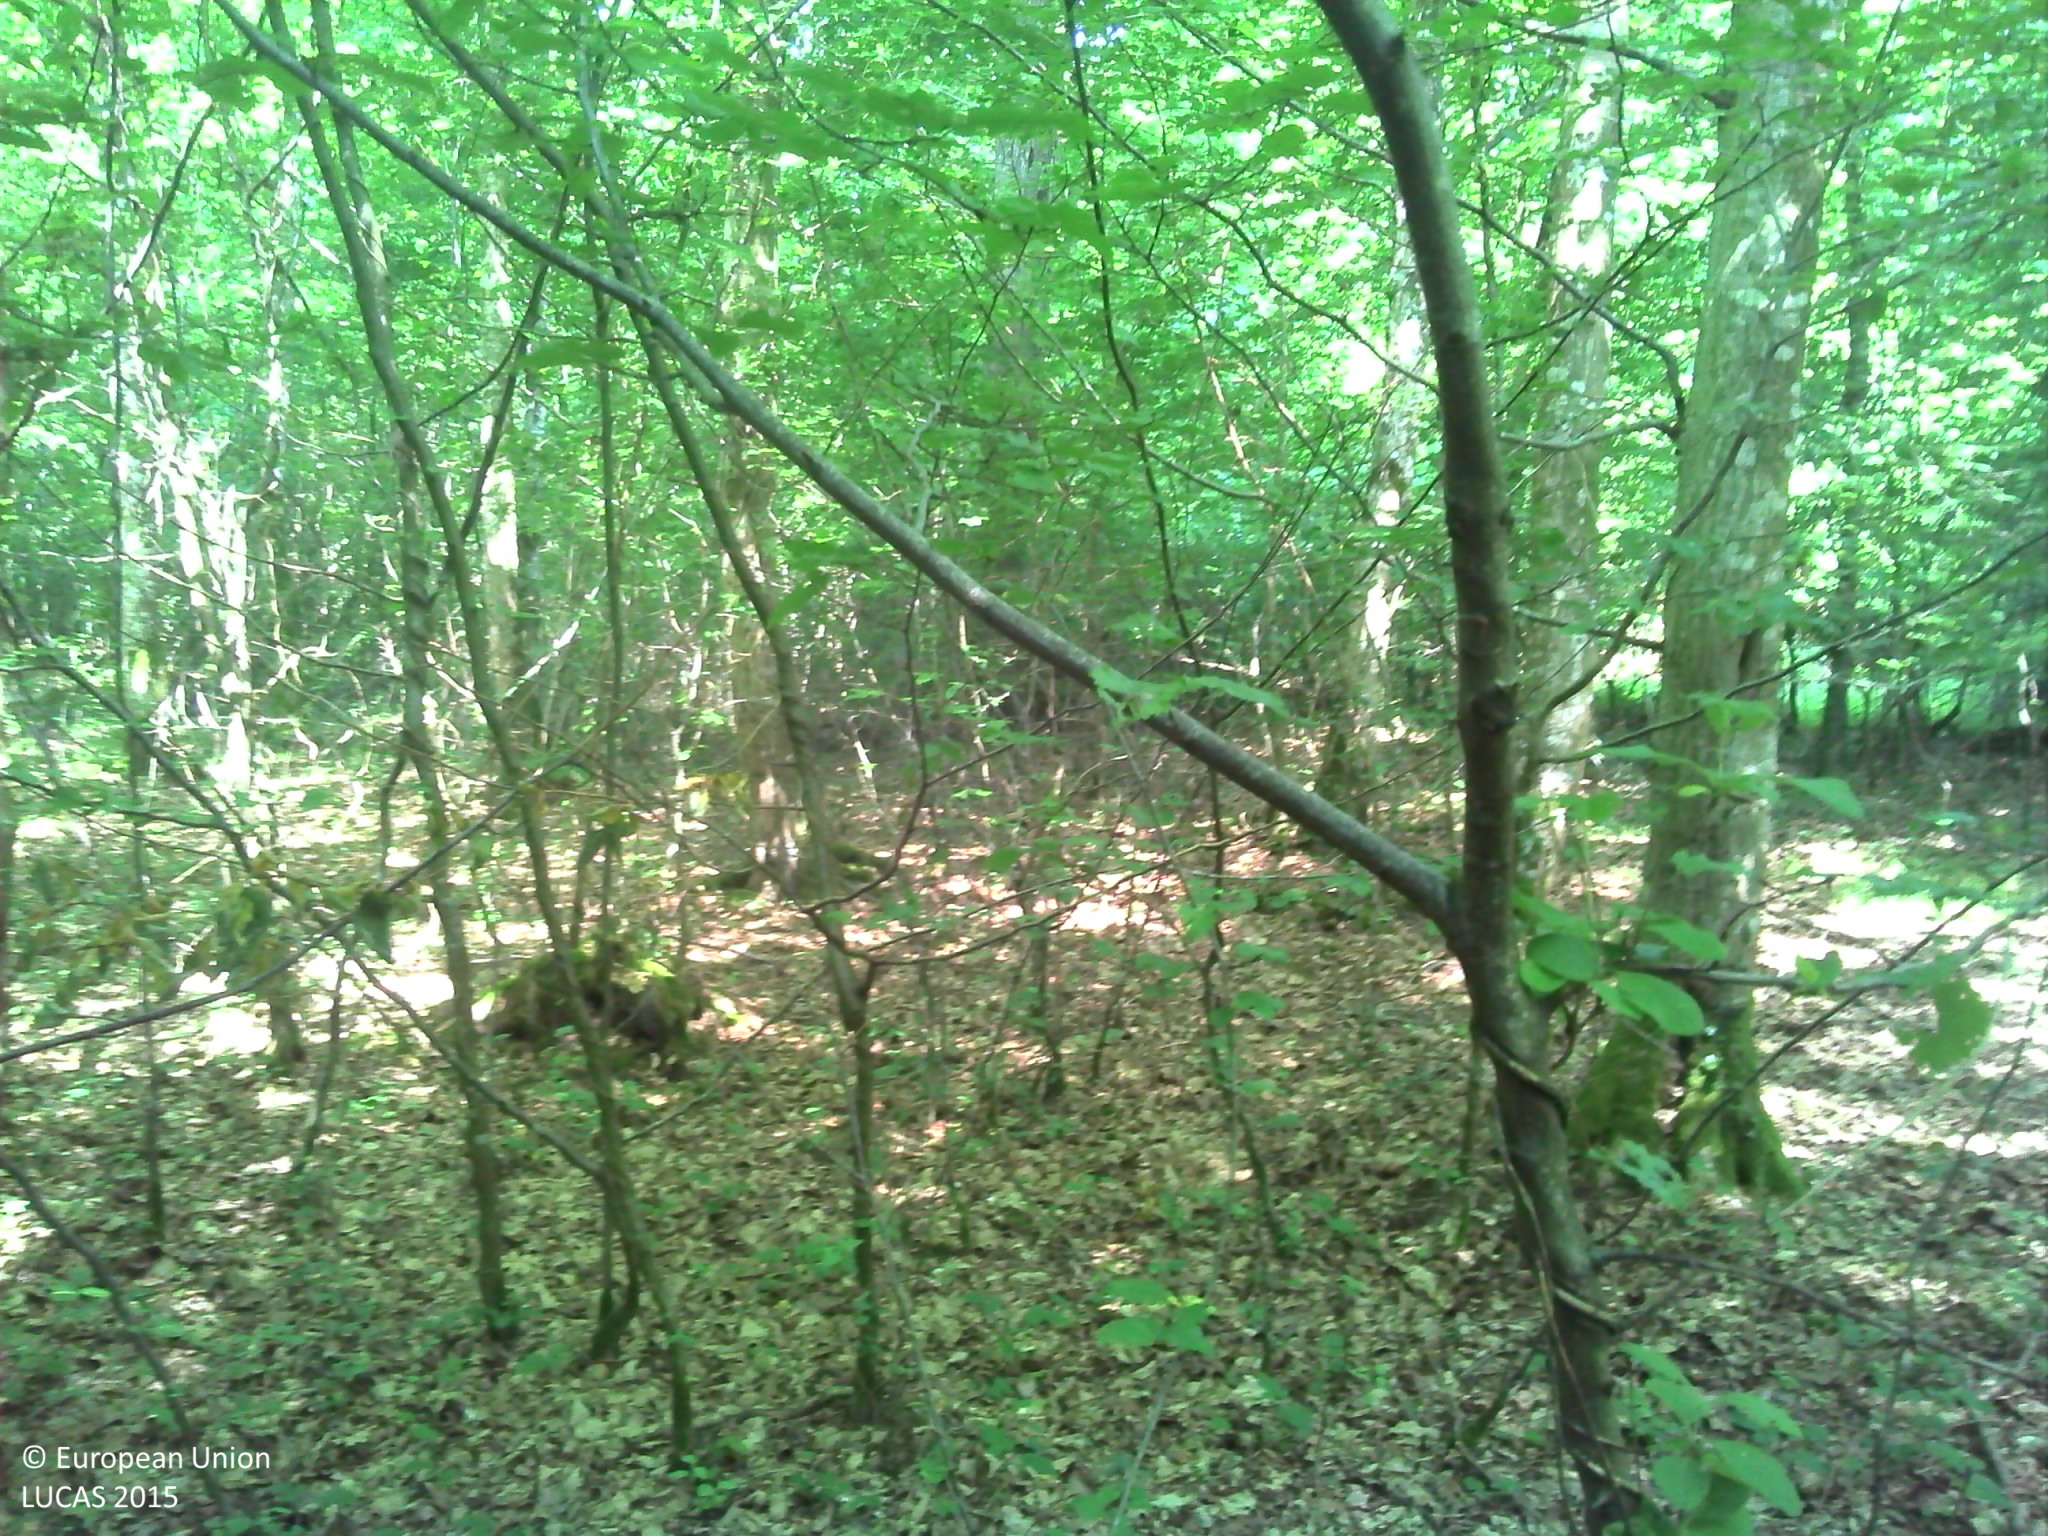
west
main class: Woodland
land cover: Broadleaved woodland
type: mesophytic deciduous forest
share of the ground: > 75 %
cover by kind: broadleaved forest trees 80 %, herbaceous plants 10 %, consolidated bare surface 10 %
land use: Forestry
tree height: > 5 m
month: July
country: FR
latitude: 48.9682
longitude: 1.1139
